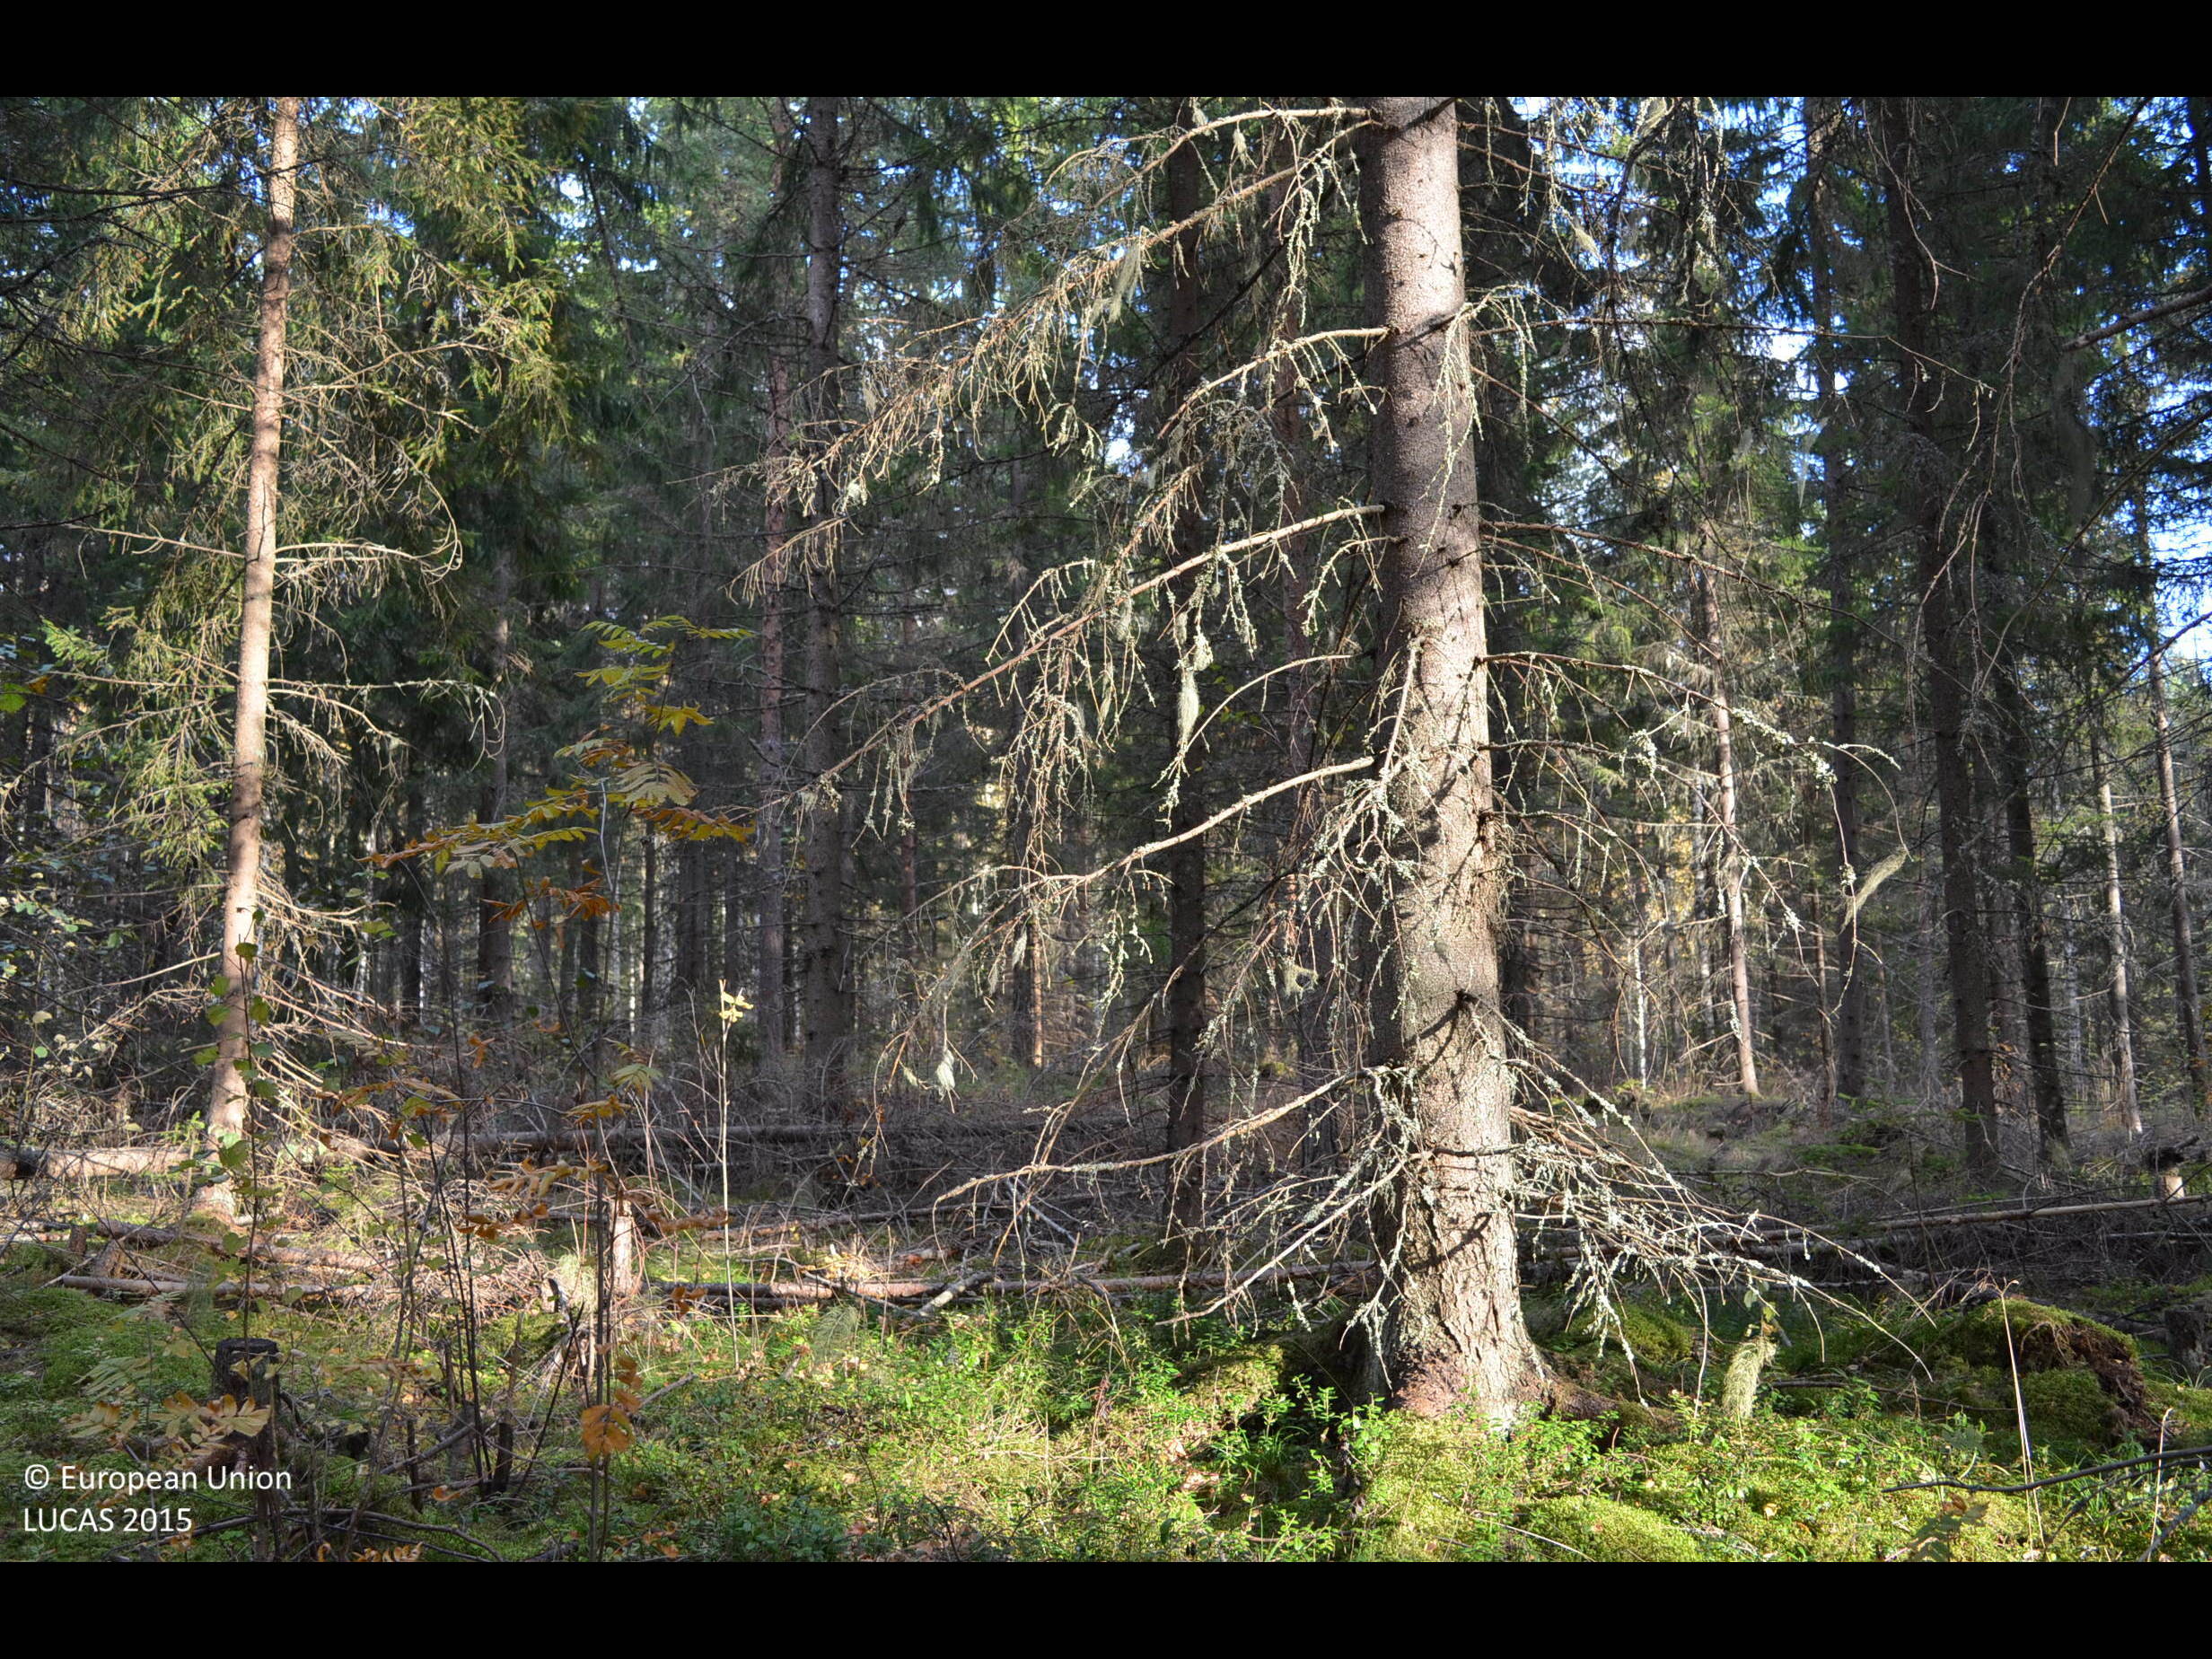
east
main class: Woodland
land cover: Spruce dominated coniferous woodland
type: boreal forest
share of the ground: > 75 %
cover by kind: coniferous forest trees 70 %, broadleaved forest trees 5 %, shrubs 5 %, herbaceous plants 5 %, lichens and mosses 5 %
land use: Forestry
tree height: > 5 m
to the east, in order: Spruce dominated coniferous woodland; Broadleaved woodland; Spruce dominated mixed woodland; Pine dominated coniferous woodland; Other mixed woodland
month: October
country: FI
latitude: 61.7125
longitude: 23.8355
